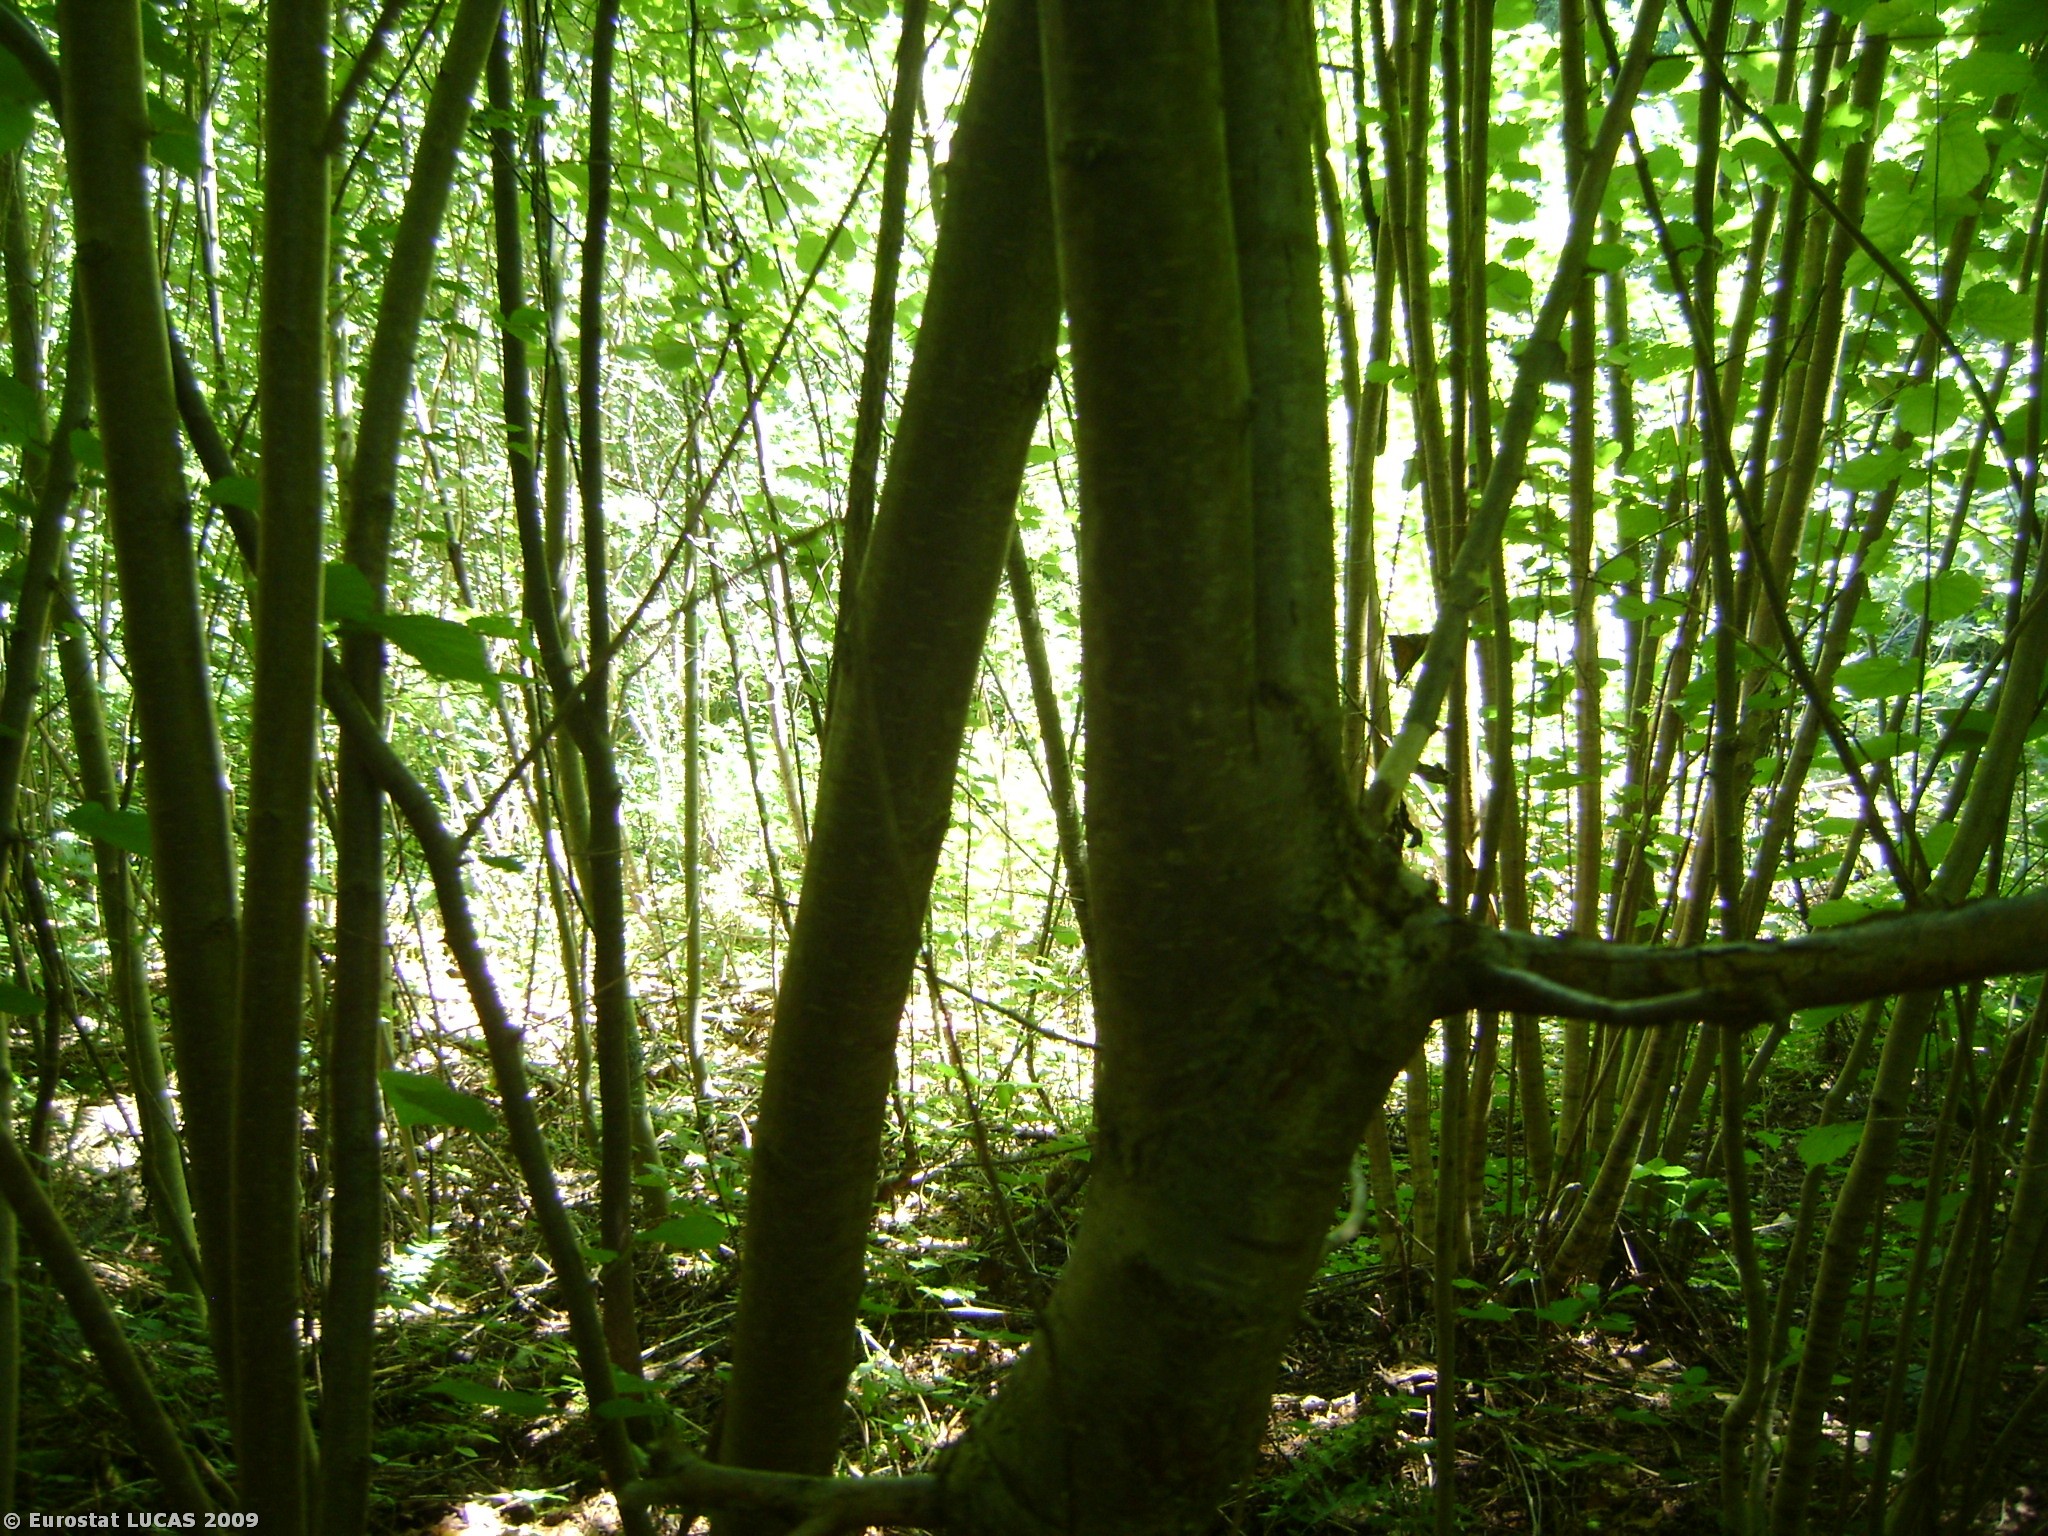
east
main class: Woodland
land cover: Broadleaved woodland
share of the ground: > 75 %
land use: Forestry
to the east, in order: Broadleaved woodland; Mixed woodland; Ditches and canals; Mixed woodland; Broadleaved woodland; Tracks; Broadleaved woodland
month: July
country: AT
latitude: 47.1971
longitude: 9.6703
